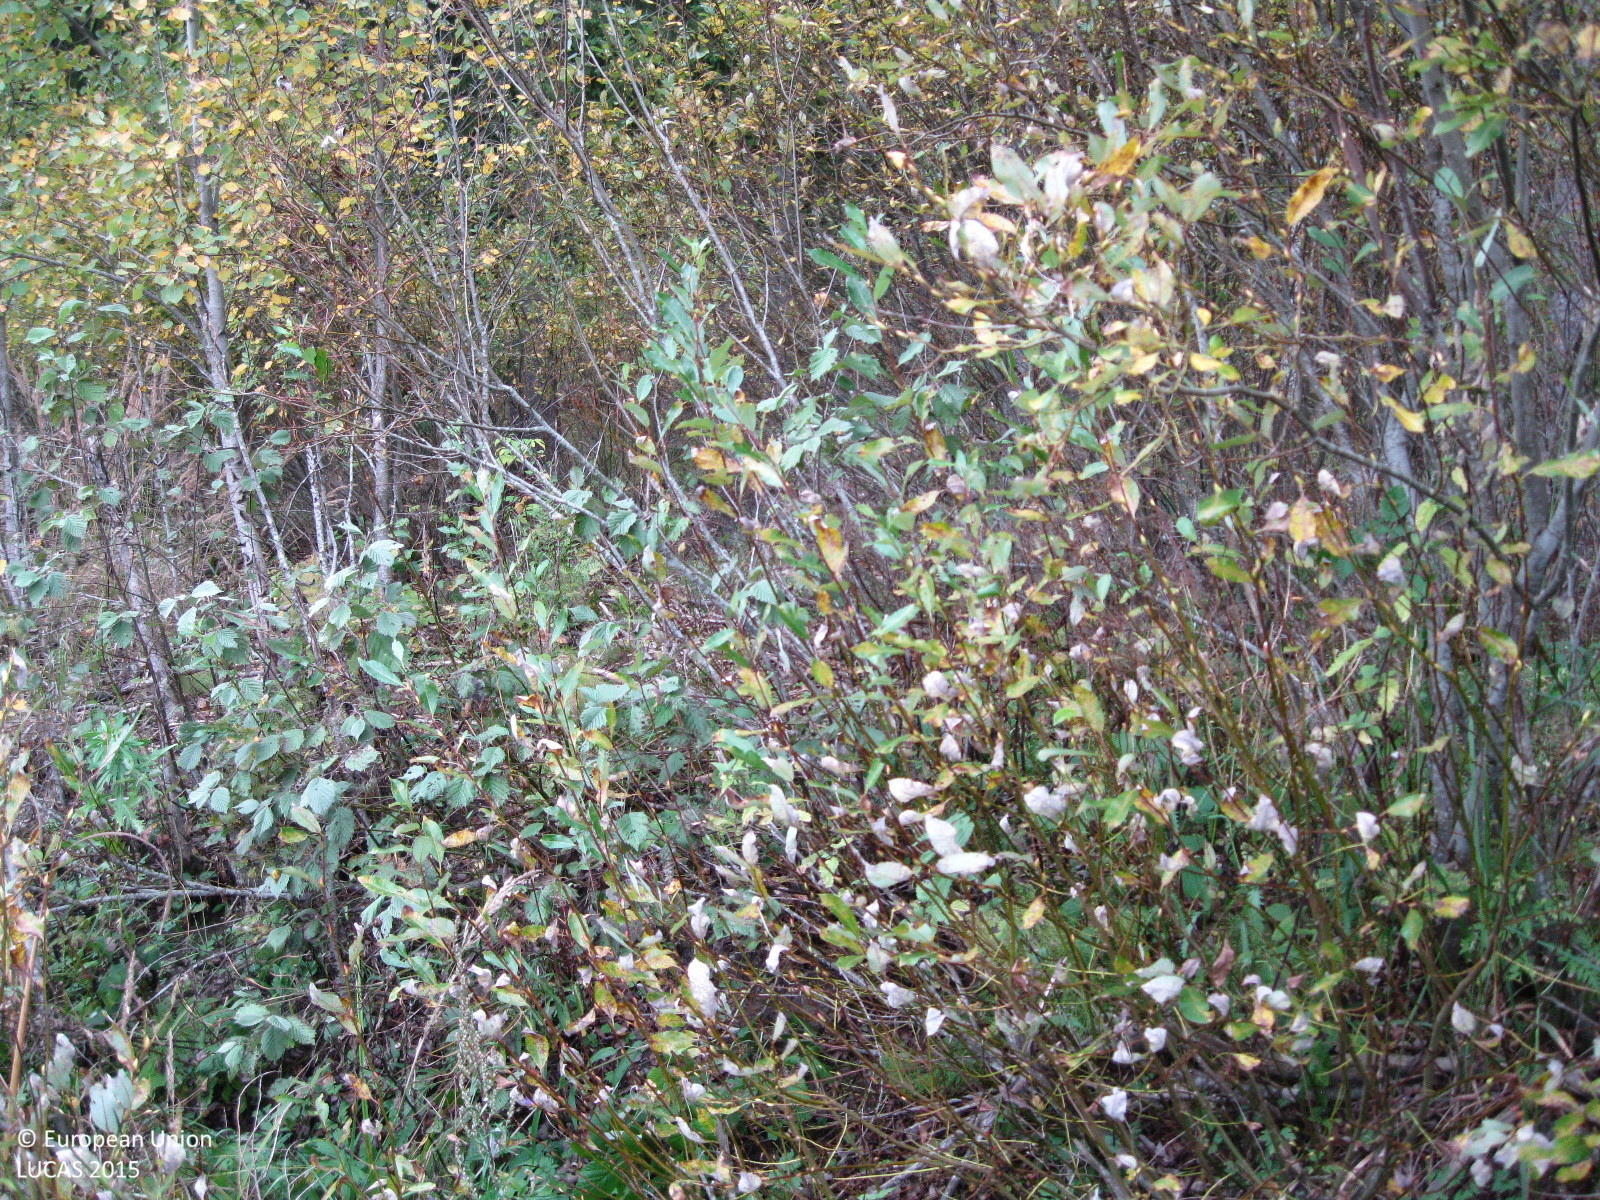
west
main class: Woodland
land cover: Broadleaved woodland
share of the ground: > 75 %
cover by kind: broadleaved forest trees 100 %
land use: Semi-natural and natural areas not in use
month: September
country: FI
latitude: 60.5981
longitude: 24.7002
